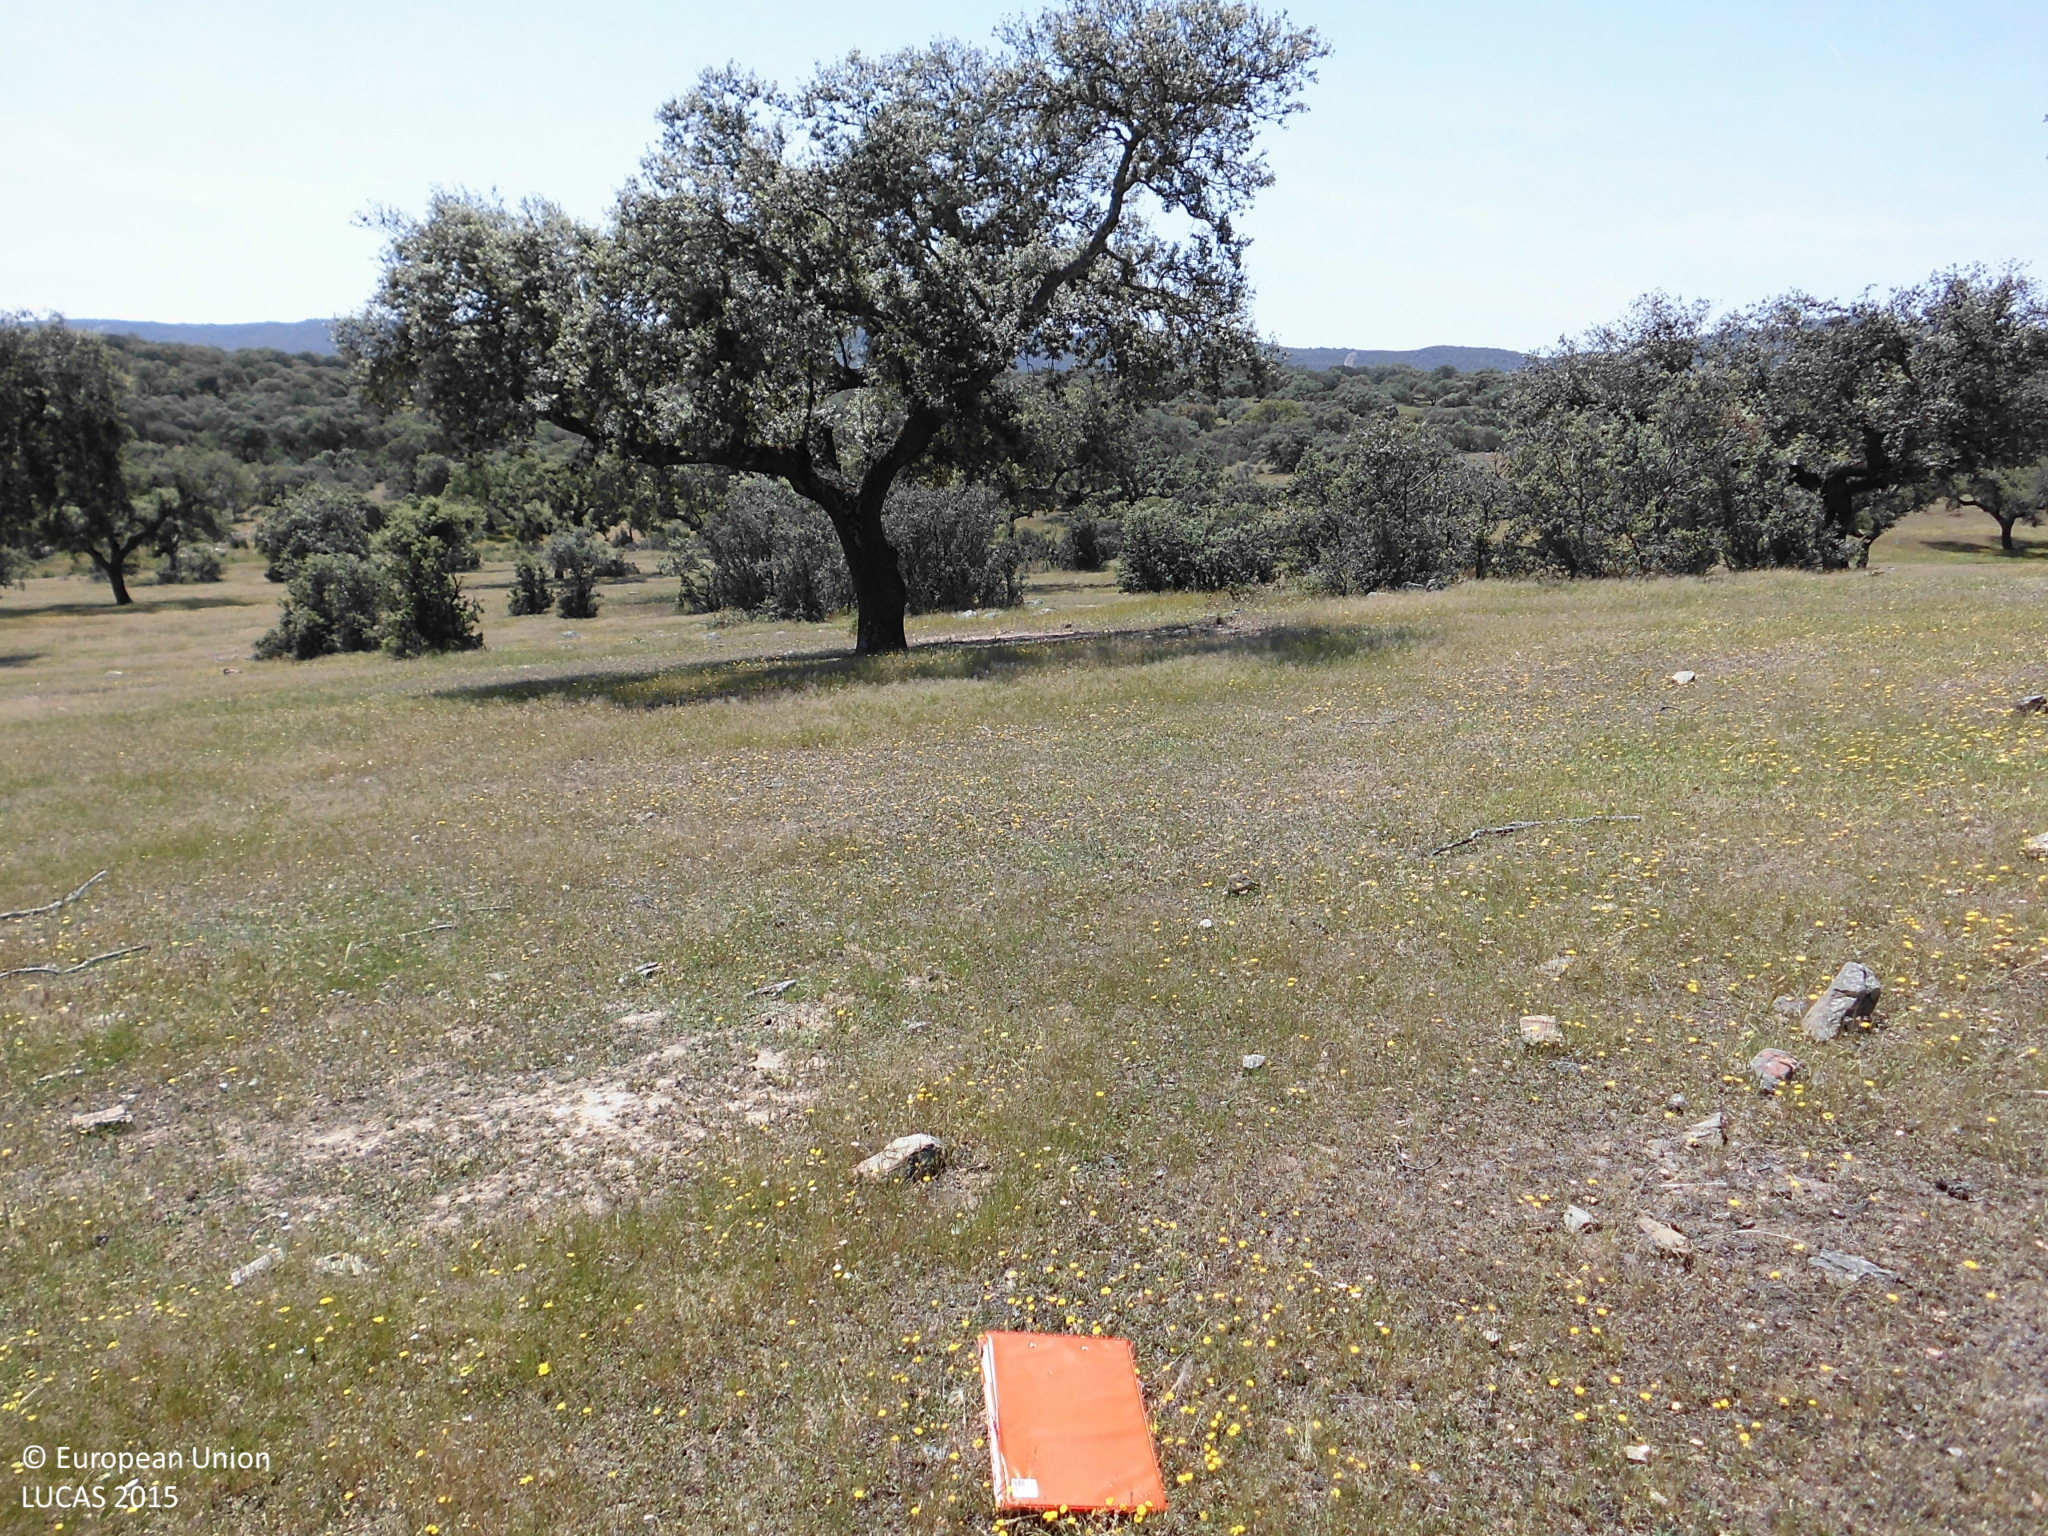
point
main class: Woodland
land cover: Broadleaved woodland
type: broadleaved evergreen forest
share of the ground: 10 - 25 %
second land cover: Grassland without tree/shrub cover
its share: > 75 %
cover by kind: herbaceous plants 85 %, broadleaved forest trees 15 %
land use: Forestry
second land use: Agriculture (excluding fallow land and kitchen gardens)
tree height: > 5 m
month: May
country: ES
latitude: 39.4786
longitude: -7.0676
